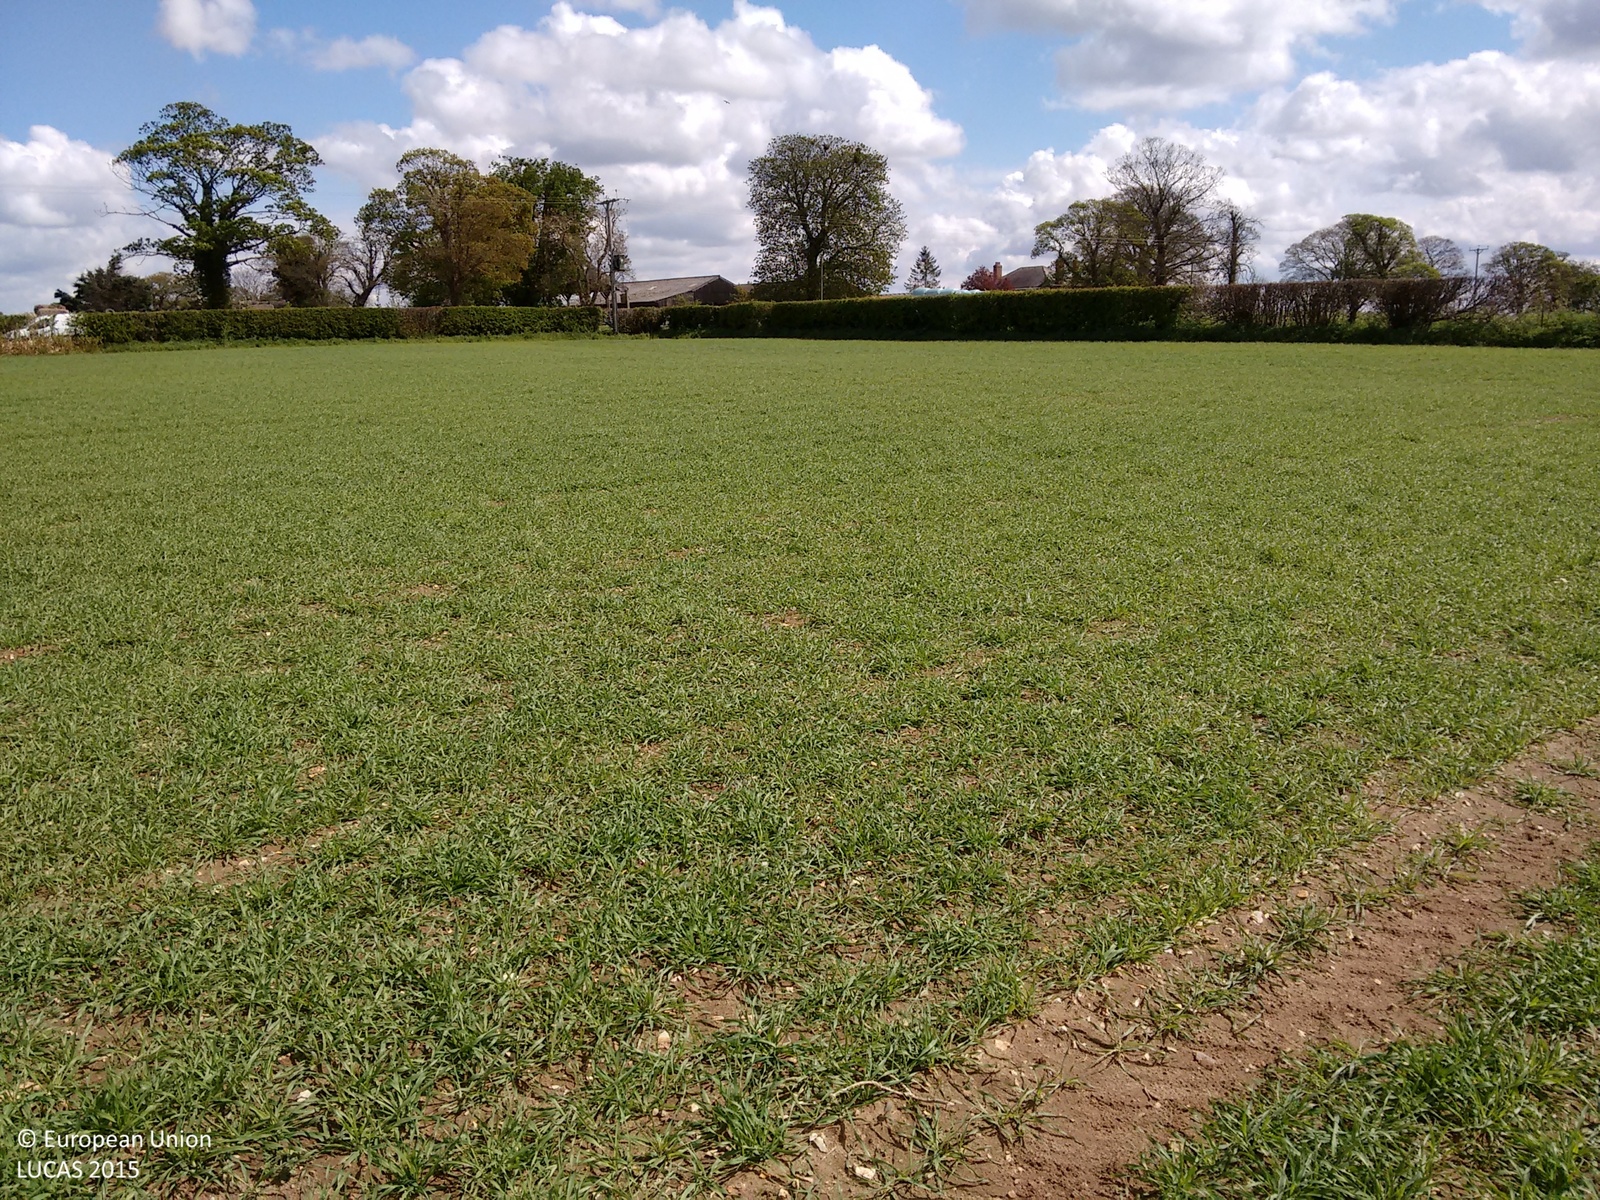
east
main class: Cropland
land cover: Barley
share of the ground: 50 - 75 %
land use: Agriculture (excluding fallow land and kitchen gardens)
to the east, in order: Barley; Electric lines; Grass margins; Managed hedges; Grass margins; Paved roads, cycling and walking lanes; Electric lines; Paved roads, cycling and walking lanes; Grassland without tree/shrub cover; Single bushes/trees; Artificial constructions in urban areas; Grassland without tree/shrub cover
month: April
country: GB
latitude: 53.1422
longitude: -0.0943
